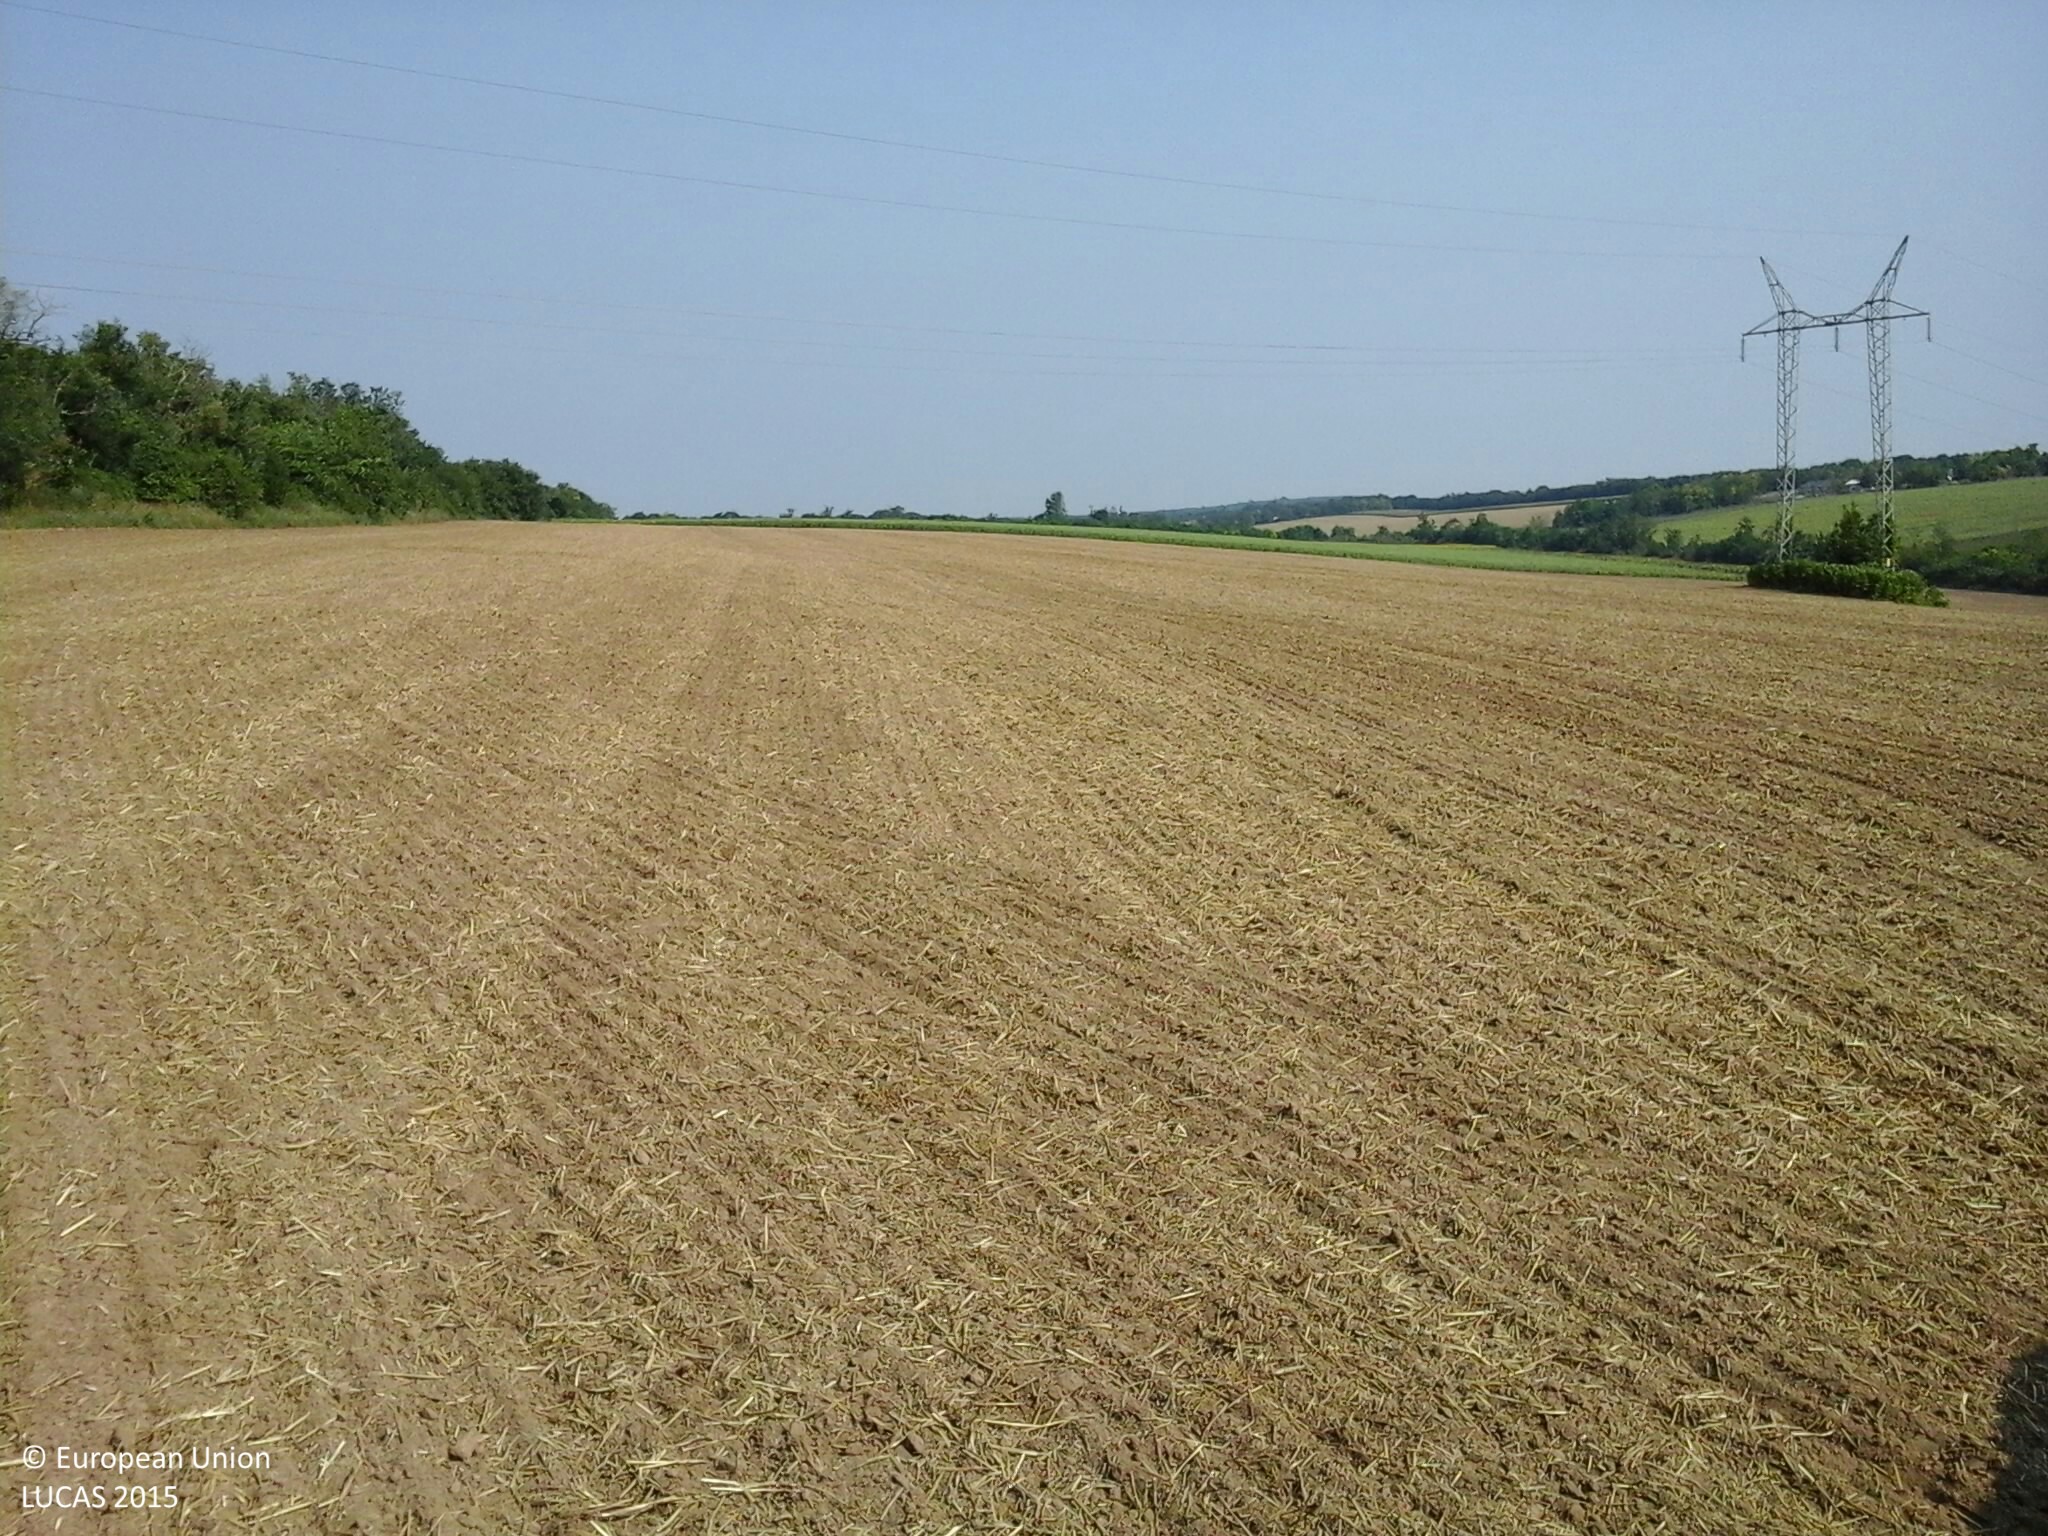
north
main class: Cropland
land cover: Durum wheat
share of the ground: < 10 %
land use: Agriculture (excluding fallow land and kitchen gardens)
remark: Harvested field
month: August
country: HU
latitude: 46.6669
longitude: 17.9939
